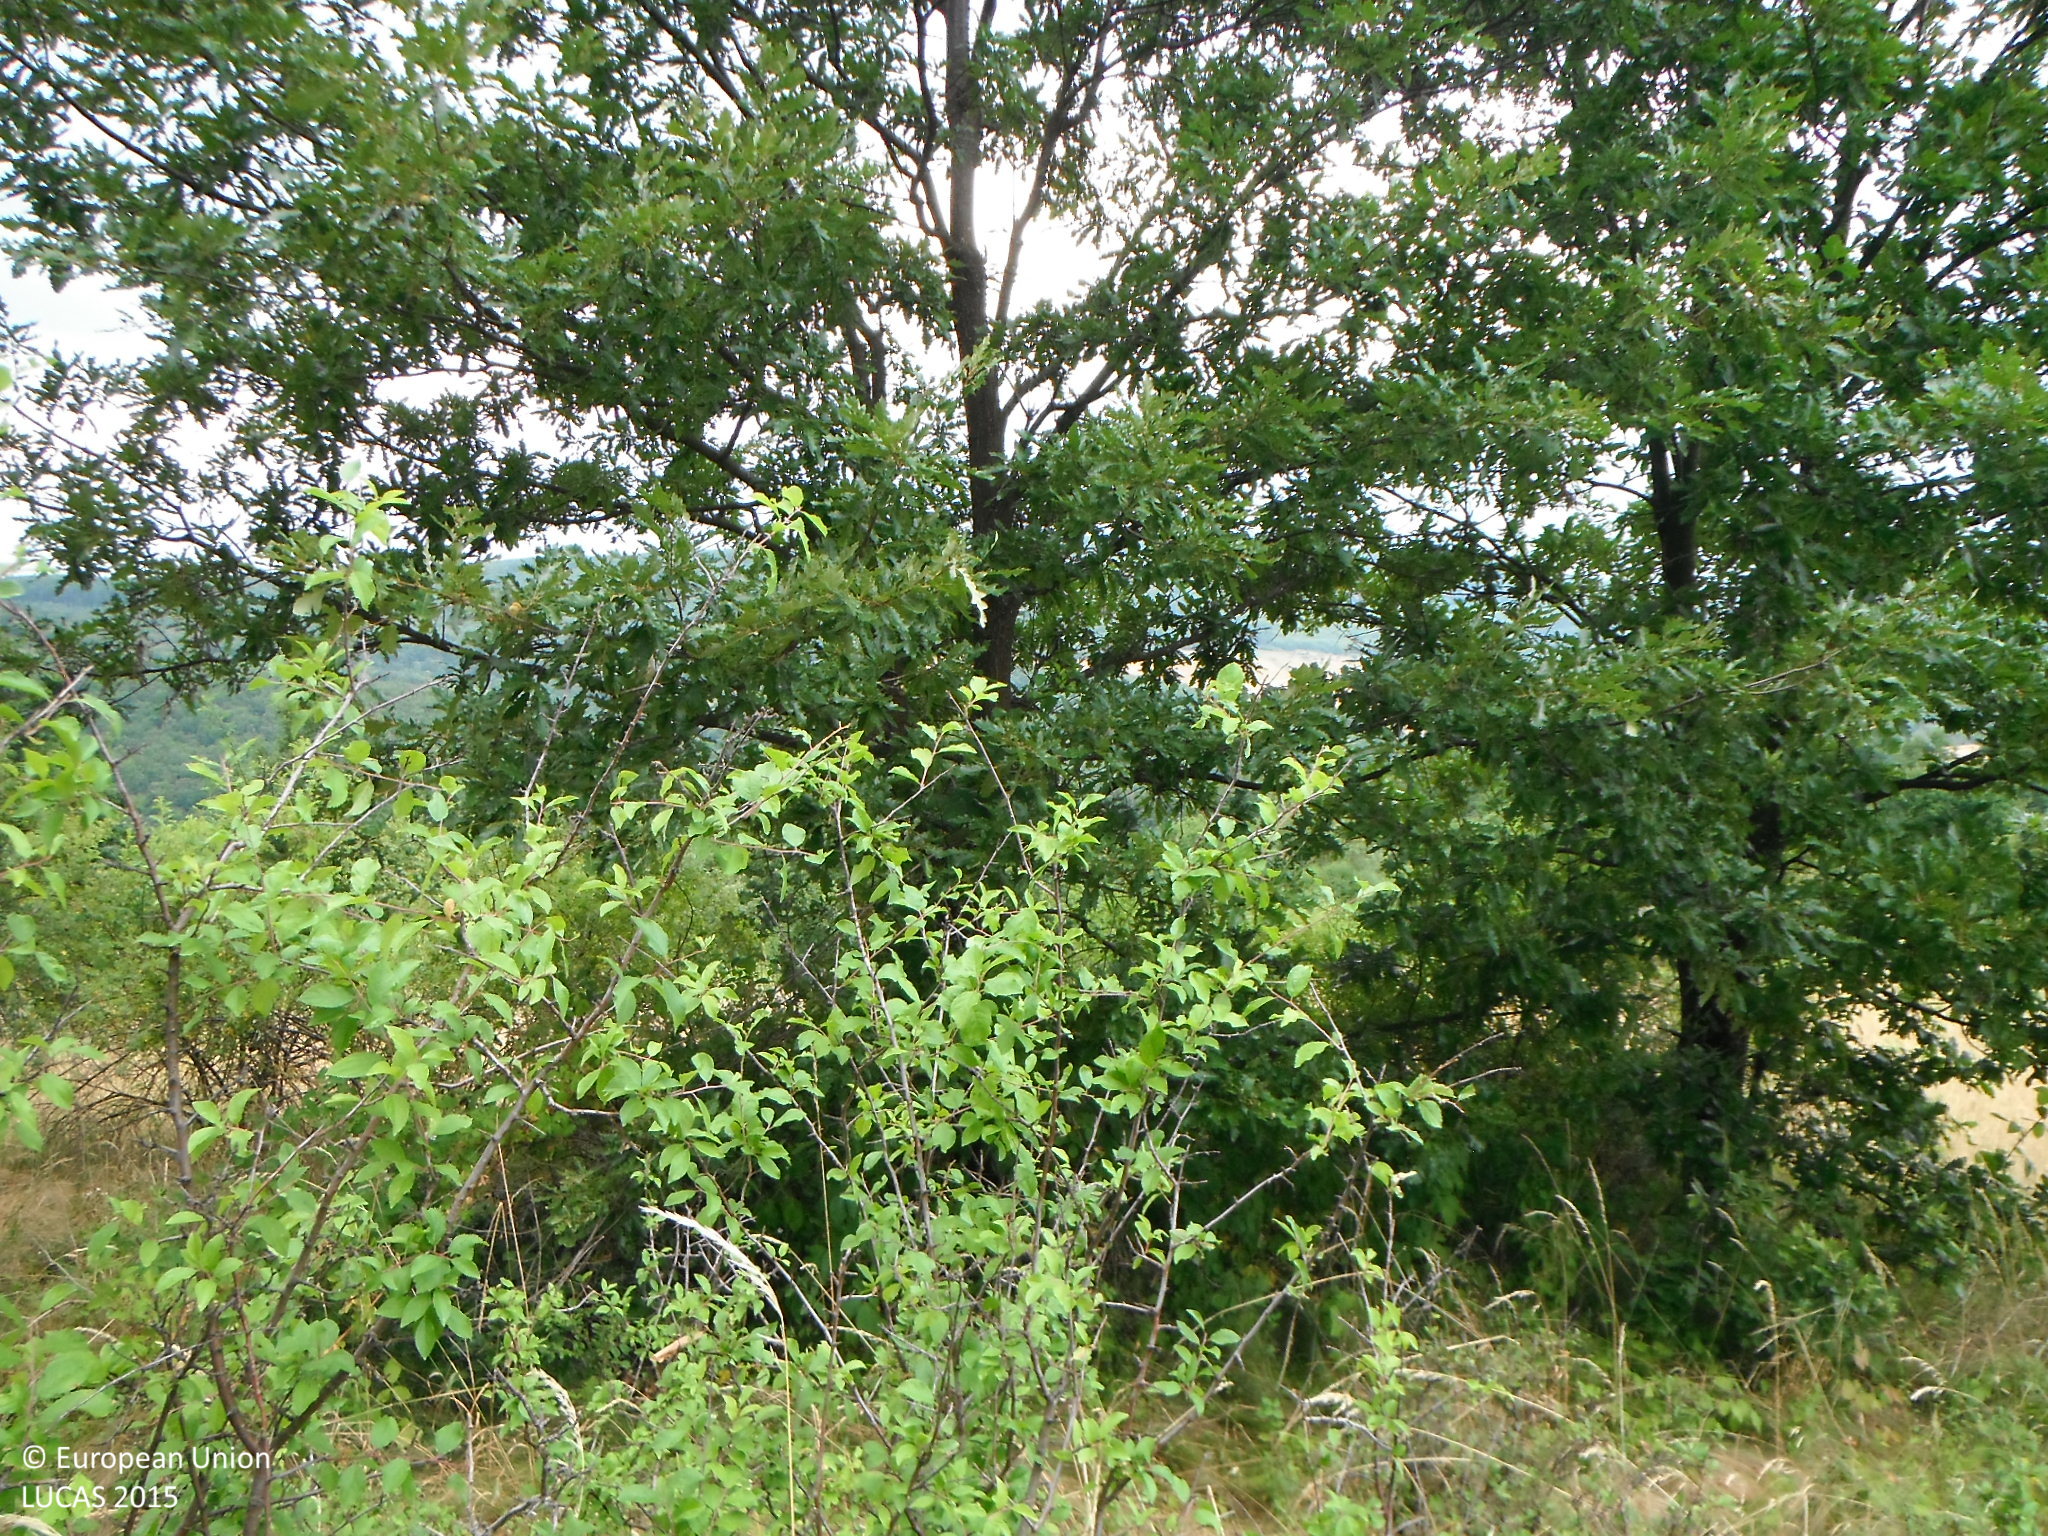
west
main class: Shrubland
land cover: Shrubland with sparse tree cover
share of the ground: > 75 %
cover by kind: shrubs 80 %, herbaceous plants 15 %, broadleaved forest trees 5 %
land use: Semi-natural and natural areas not in use
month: July
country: SK
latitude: 48.3799
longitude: 18.9990
